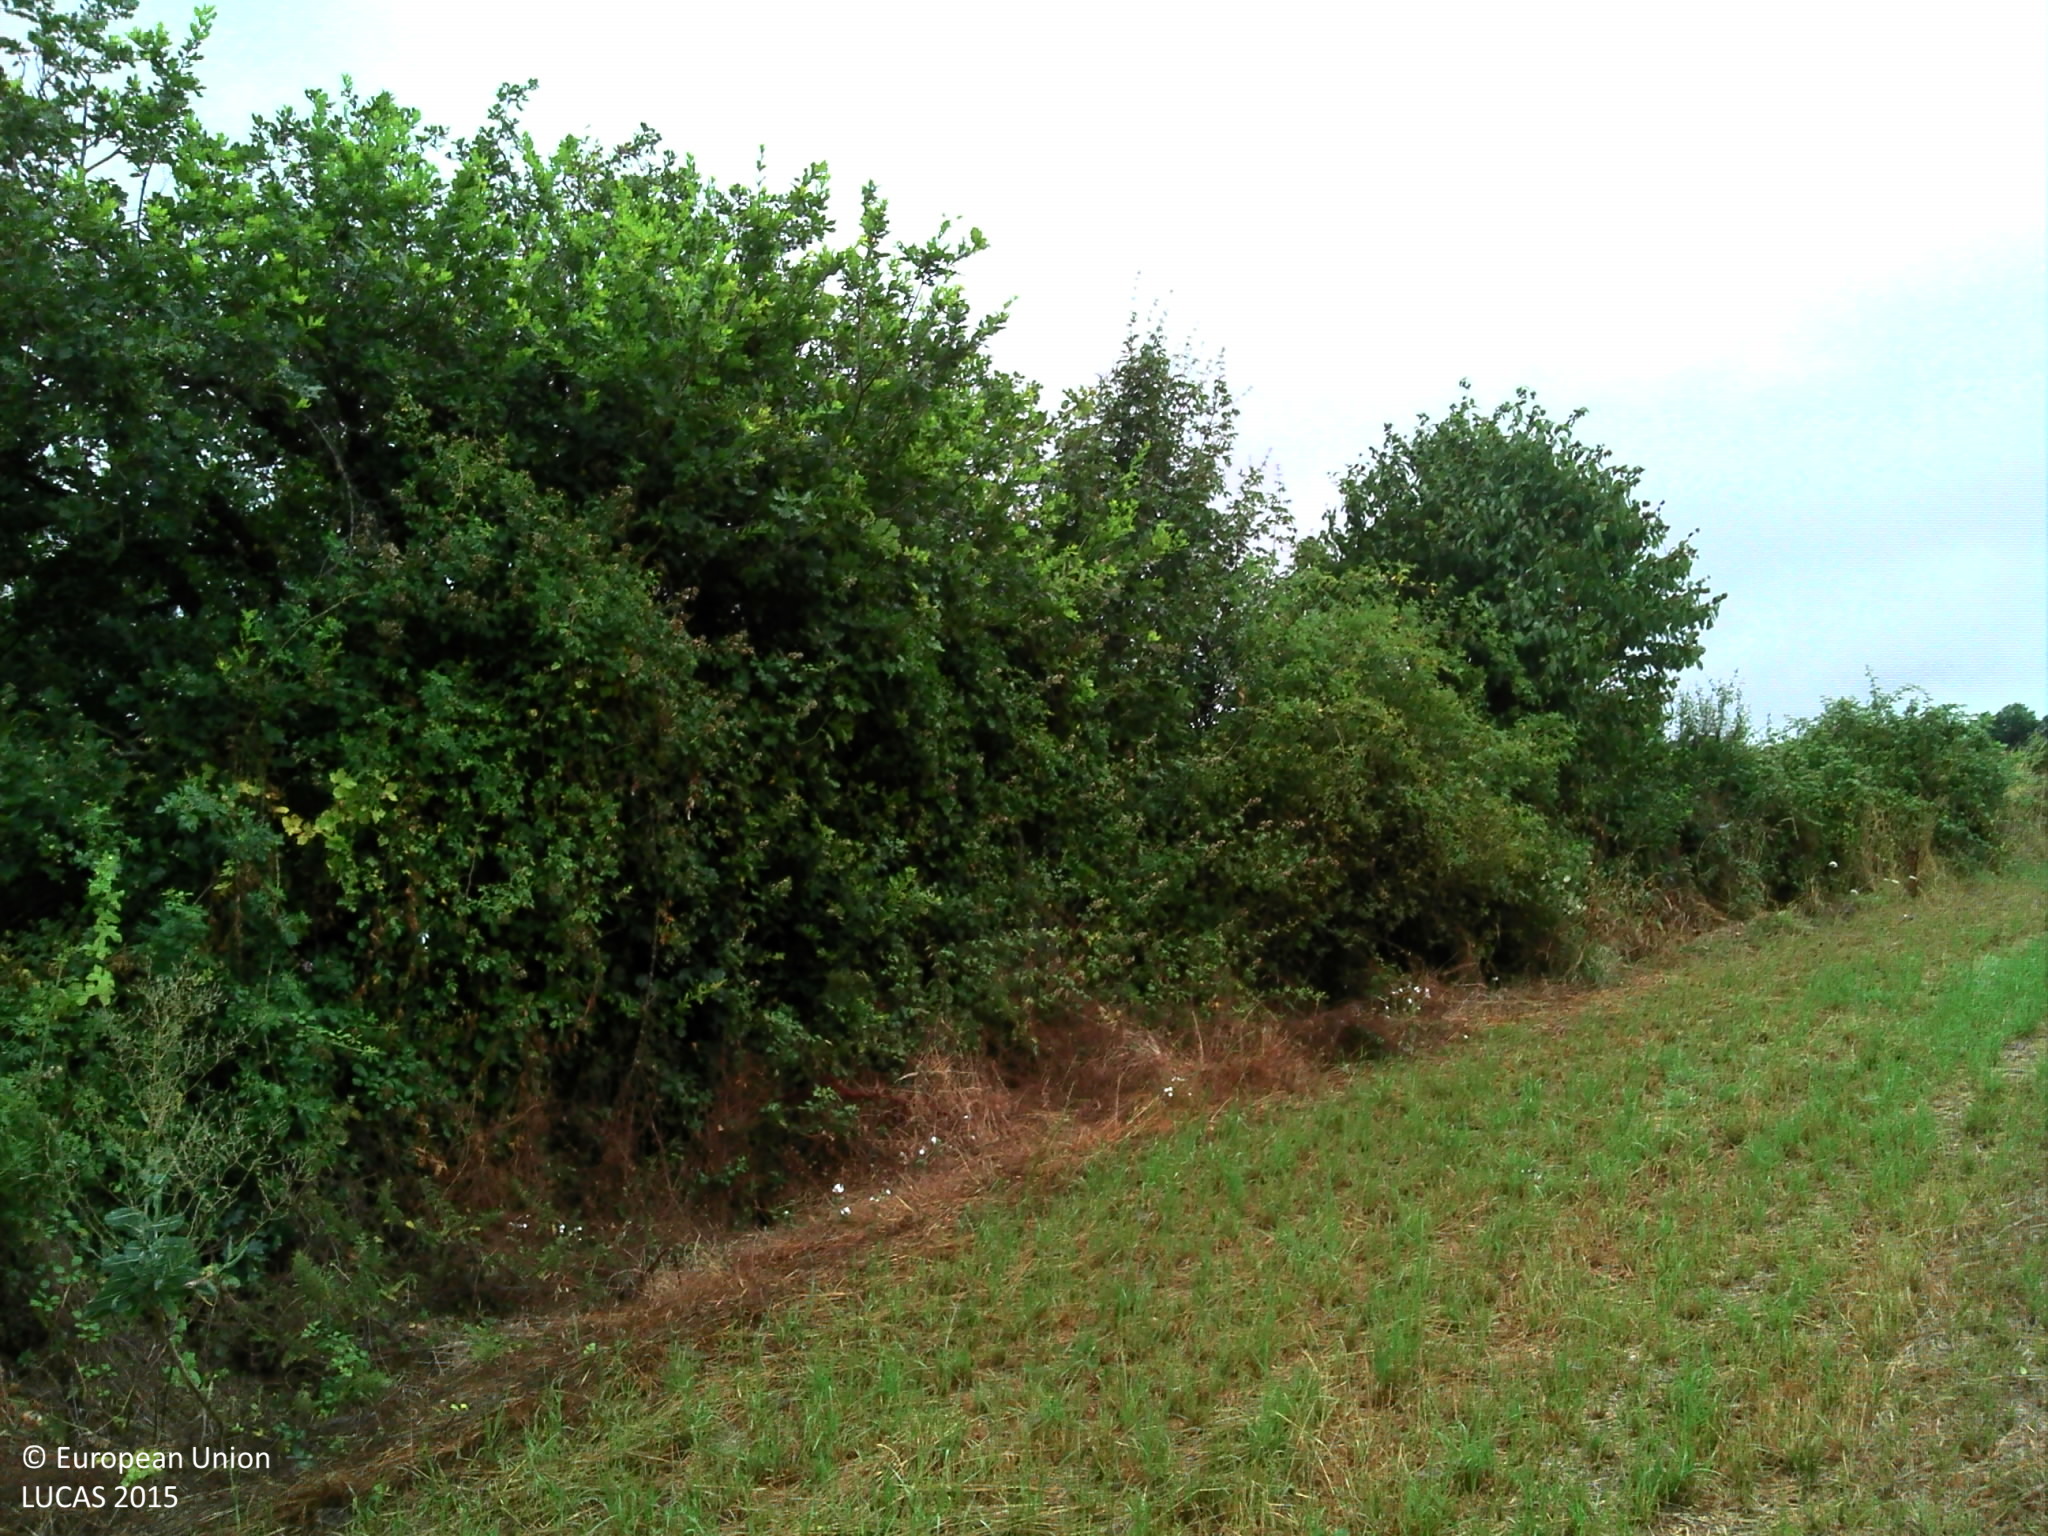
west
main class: Cropland
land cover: Temporary grasslands
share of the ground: > 75 %
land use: Agriculture (excluding fallow land and kitchen gardens)
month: July
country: FR
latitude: 48.3153
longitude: -0.1577
